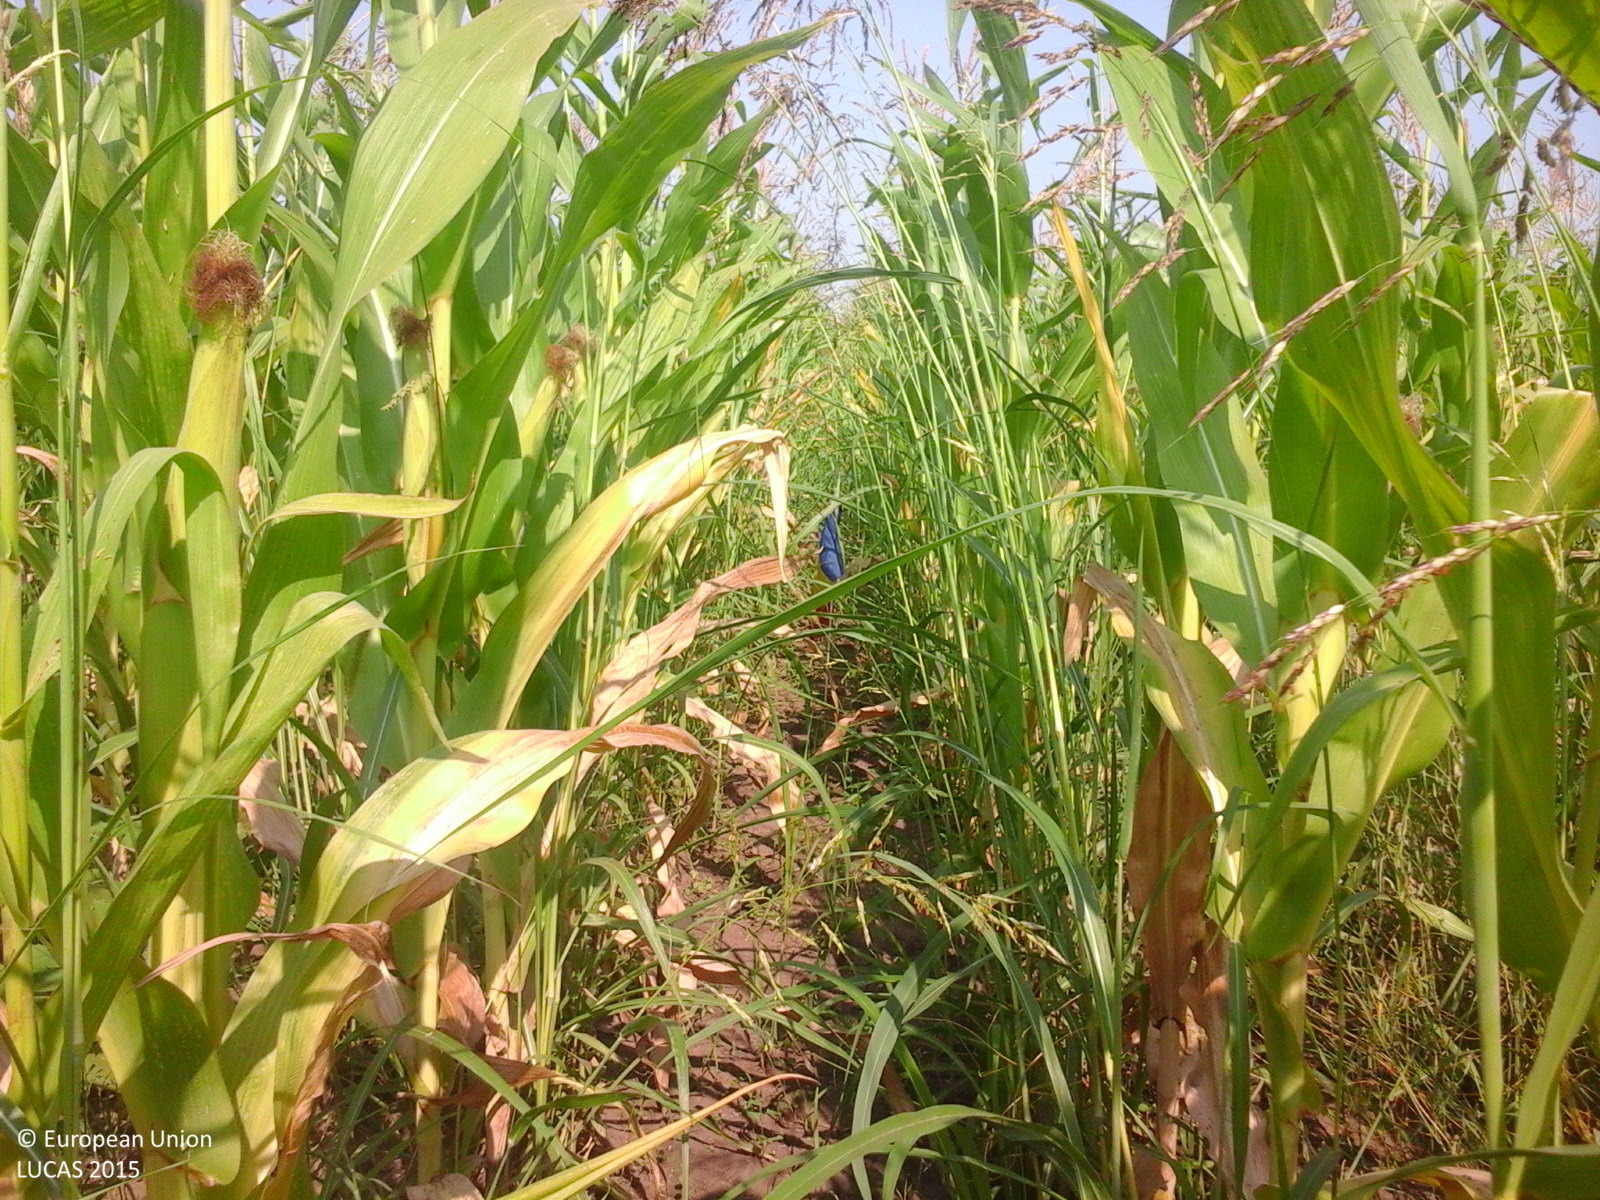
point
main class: Cropland
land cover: Maize
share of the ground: > 75 %
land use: Agriculture (excluding fallow land and kitchen gardens)
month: July
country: RO
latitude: 44.8868
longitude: 26.8801
